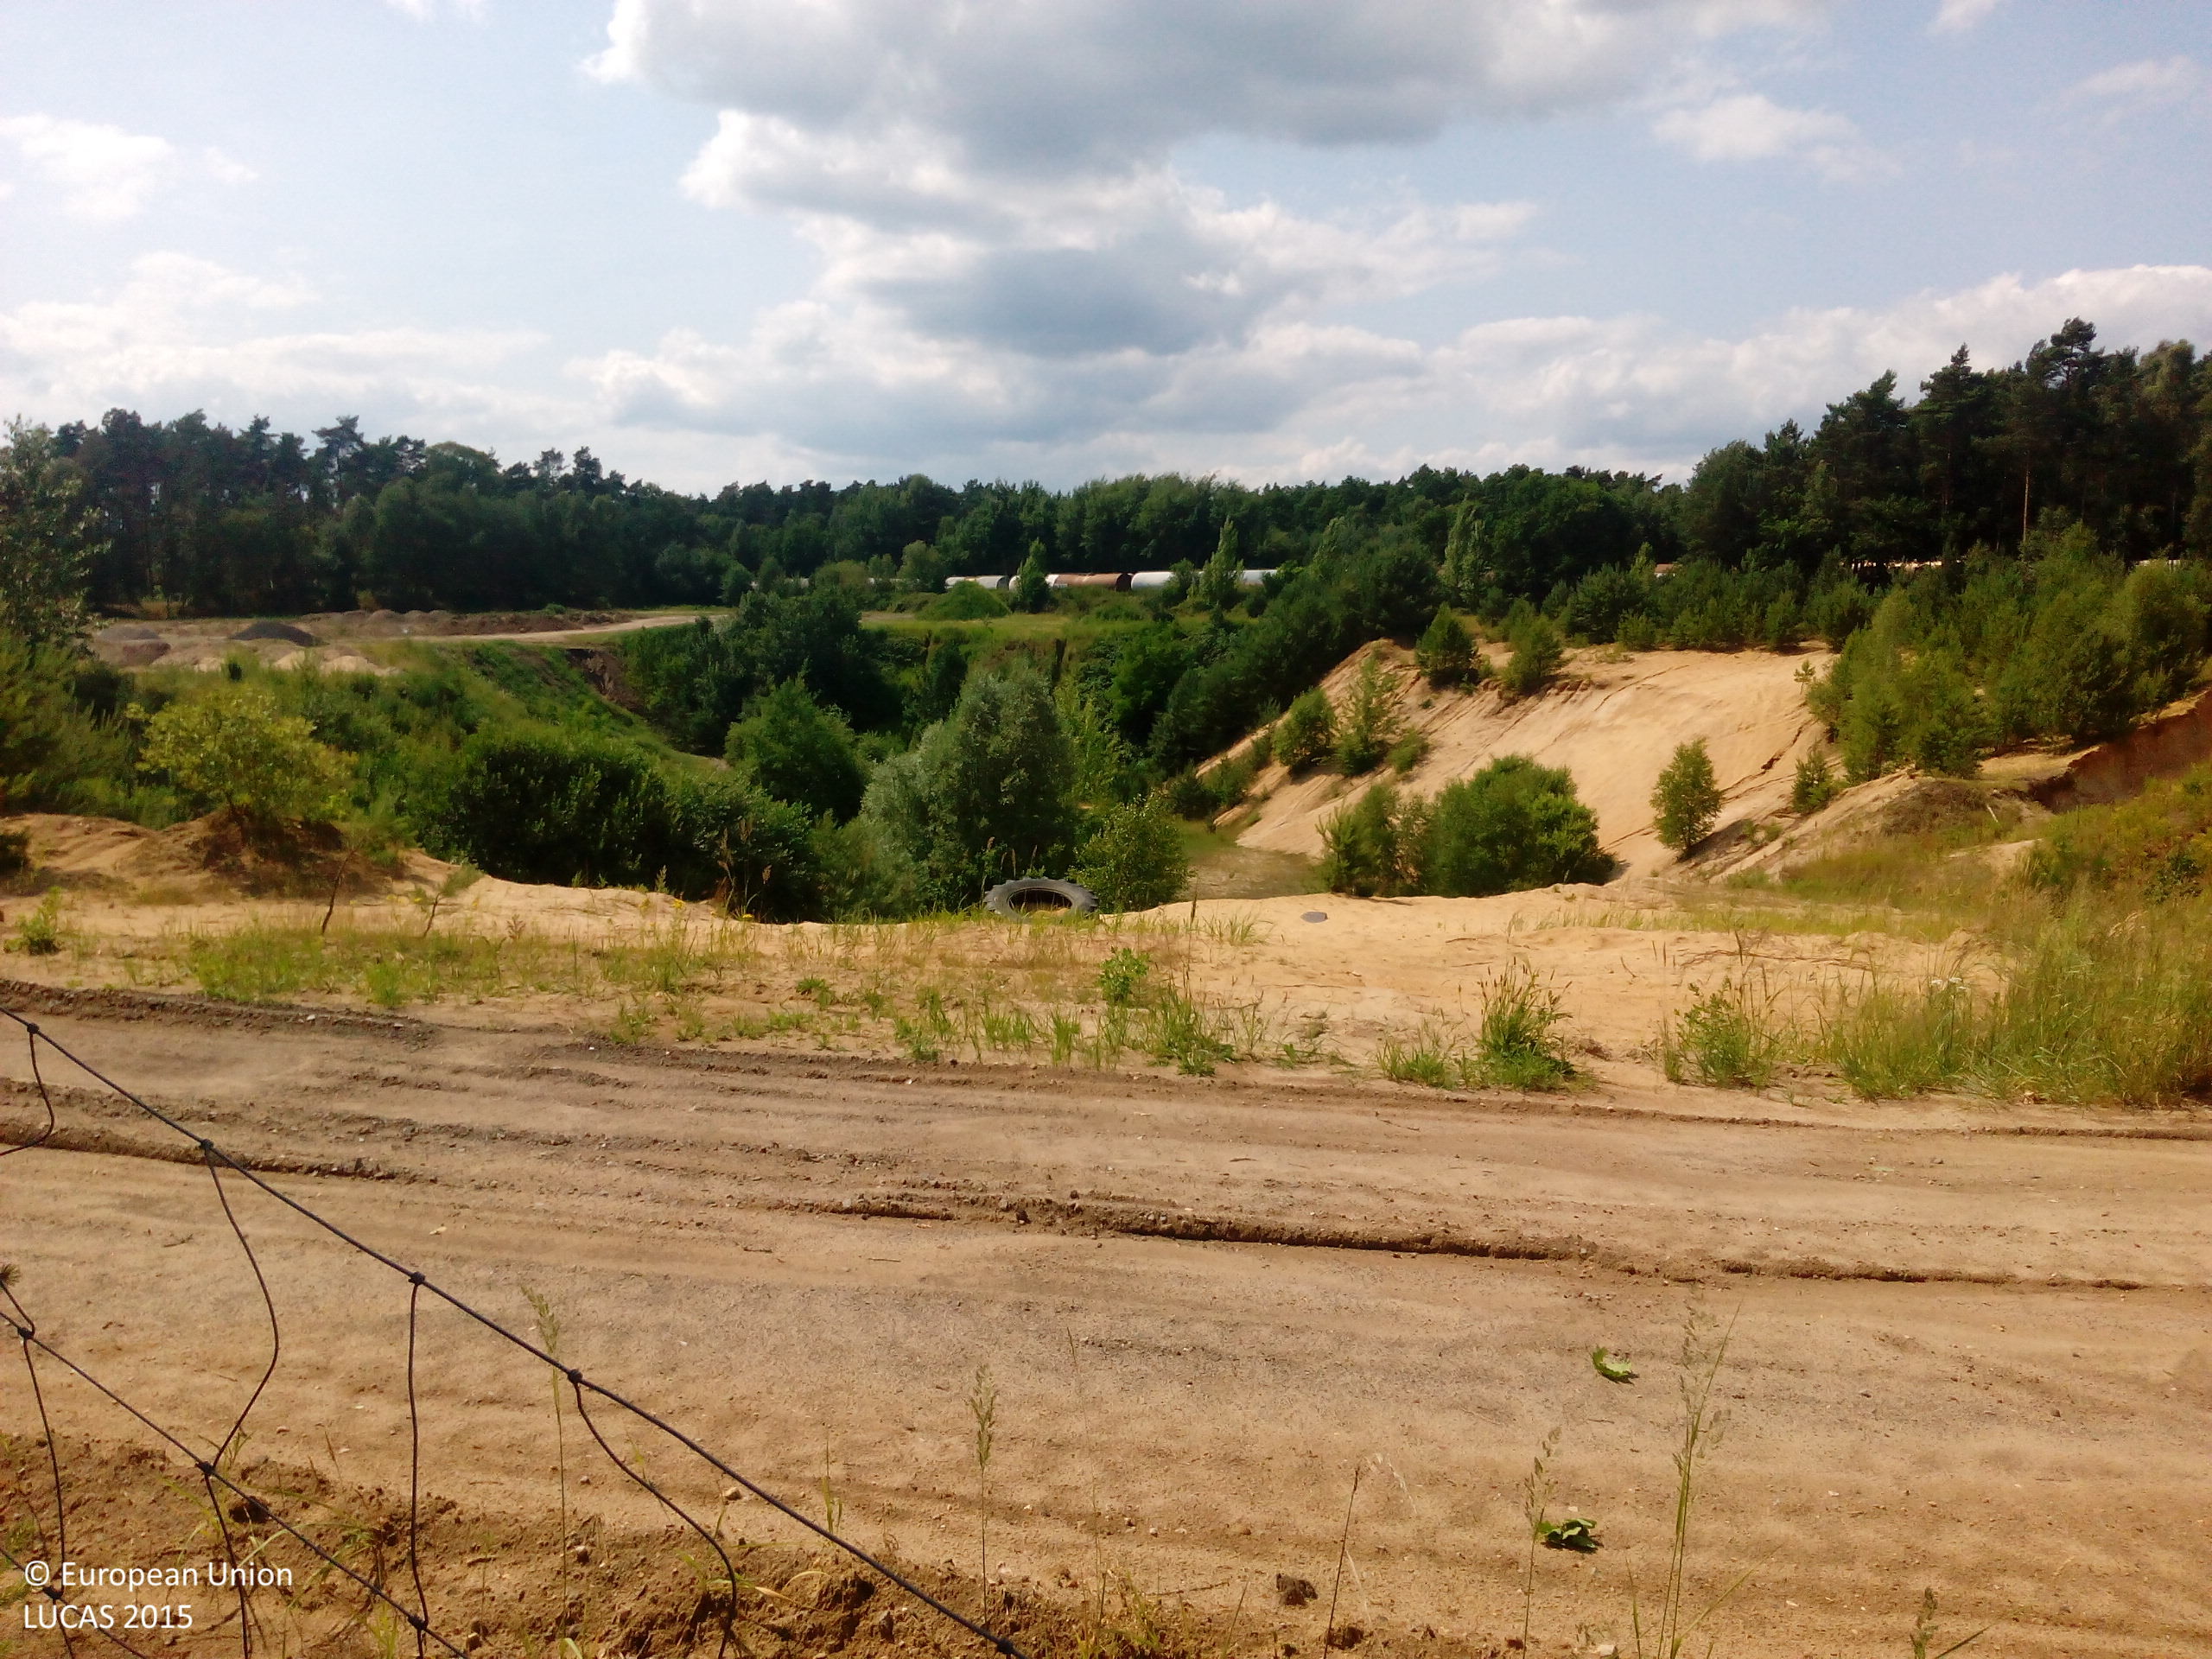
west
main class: Woodland
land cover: Pine dominated mixed woodland
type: hemiboreal forest and nemoral coniferous forest and mixed broadleaved-coniferous forest
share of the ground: > 75 %
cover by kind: coniferous forest trees 40 %, broadleaved forest trees 40 %, shrubs 20 %
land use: Mining and quarrying
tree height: > 5 m
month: July
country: DE
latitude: 52.7176
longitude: 10.5771
